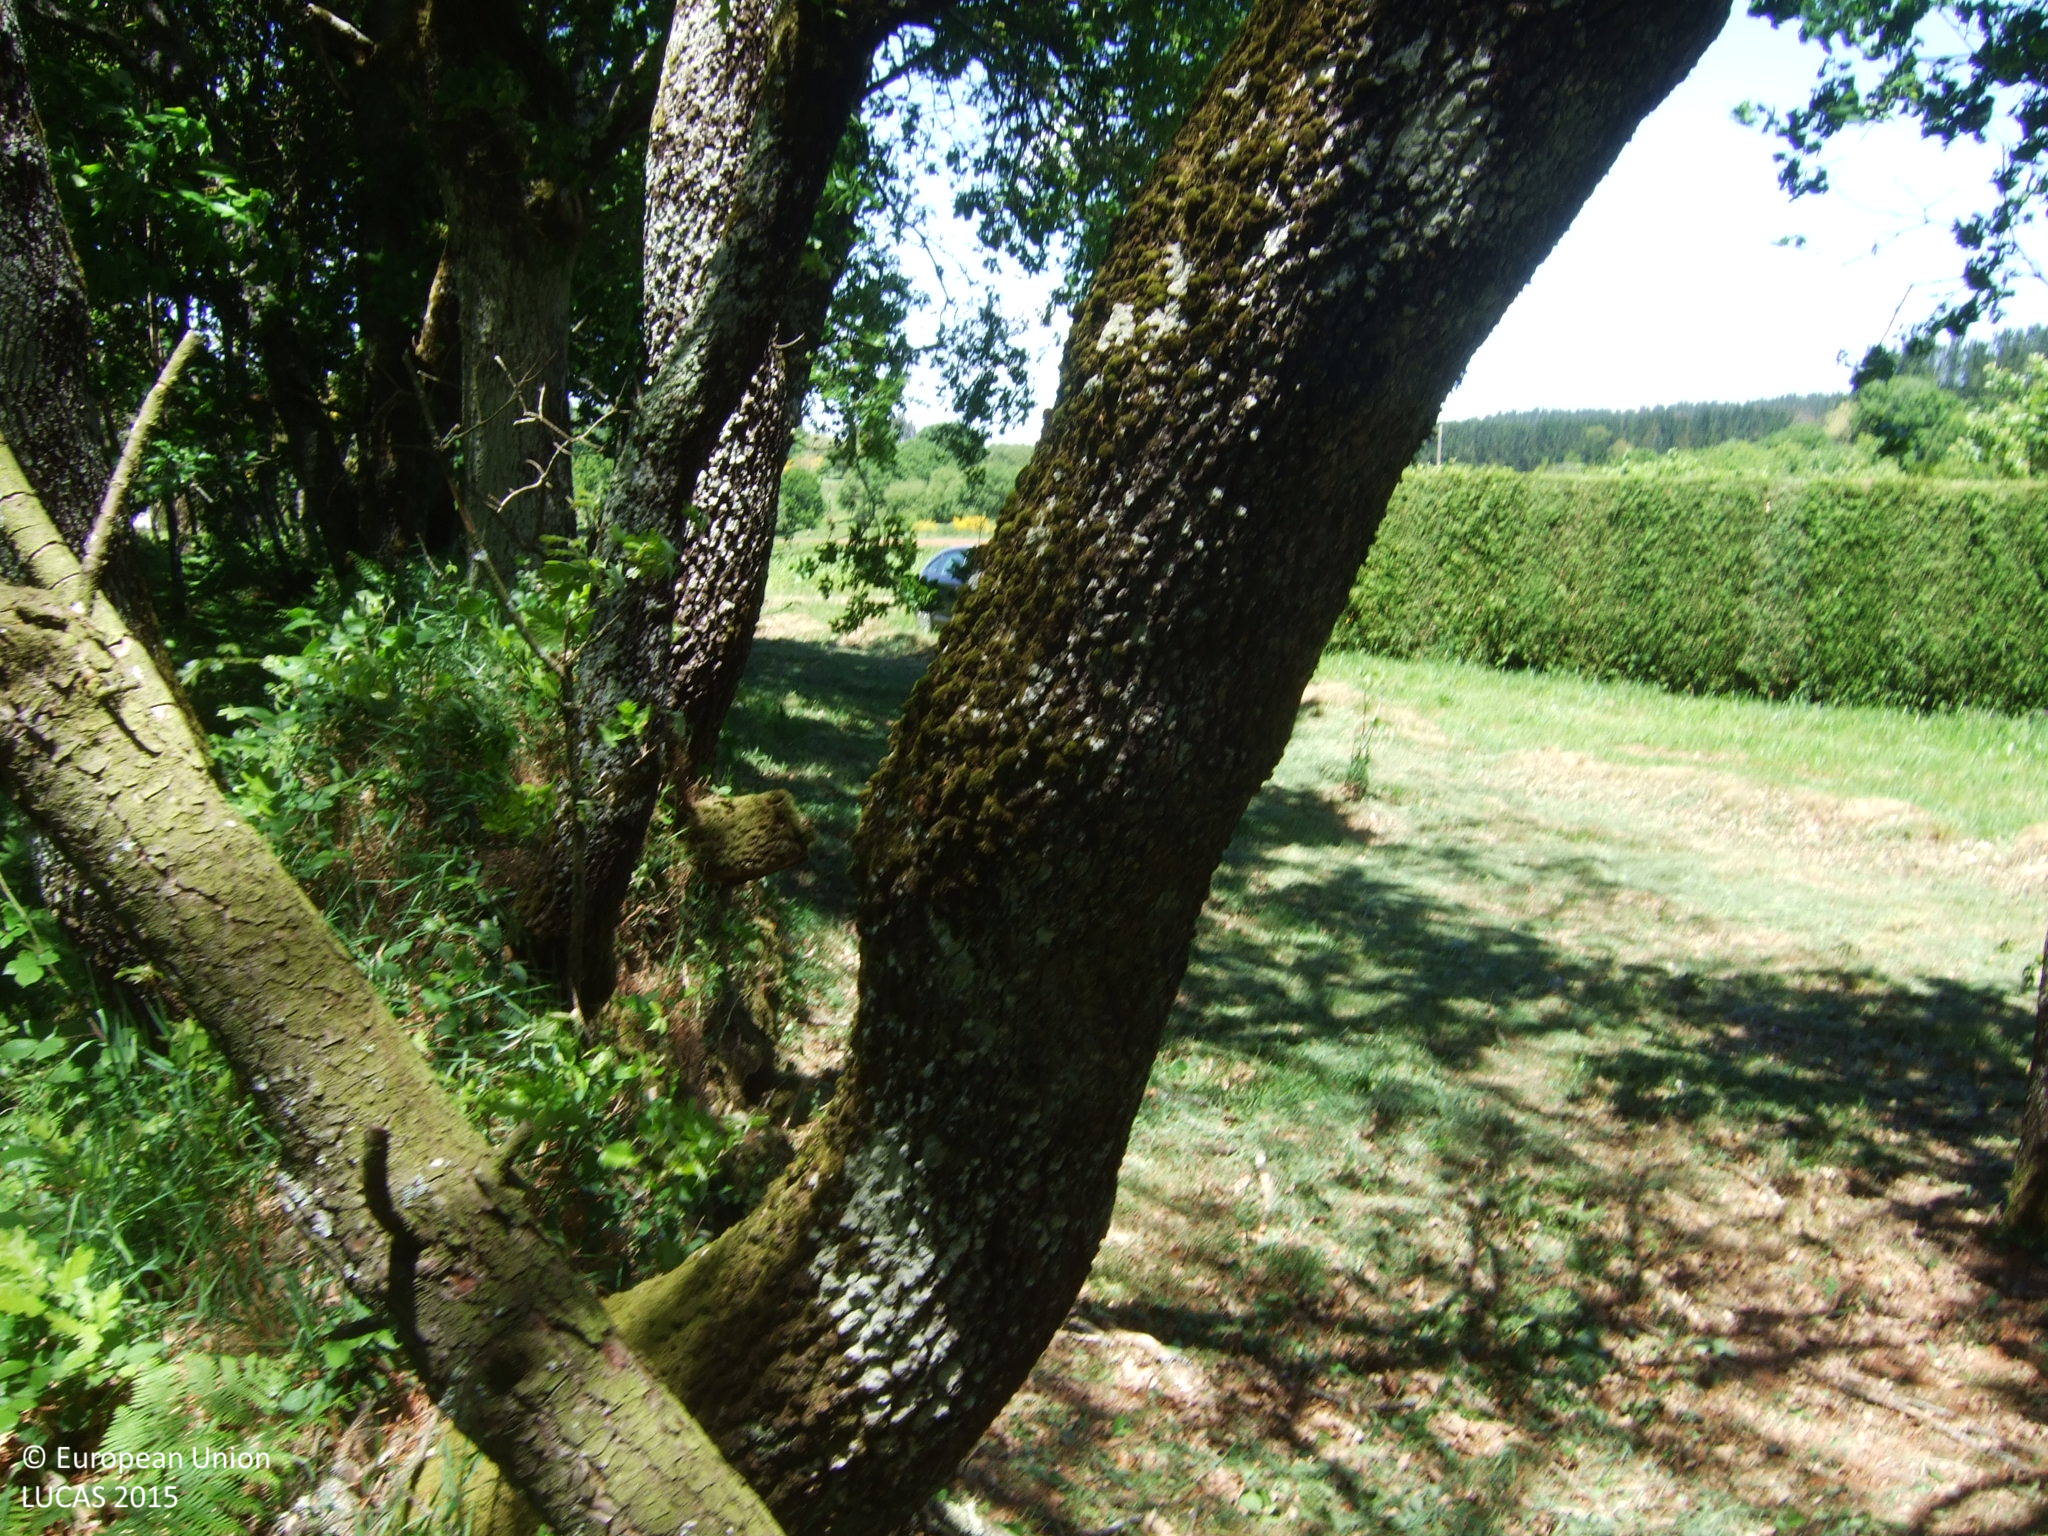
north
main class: Woodland
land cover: Pine dominated coniferous woodland
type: exotic forest
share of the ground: 50 - 75 %
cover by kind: coniferous forest trees 55 %, unconsolidated bare surface 35 %, shrubs 10 %
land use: Forestry
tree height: > 5 m
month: May
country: ES
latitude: 43.2279
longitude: -7.6523
